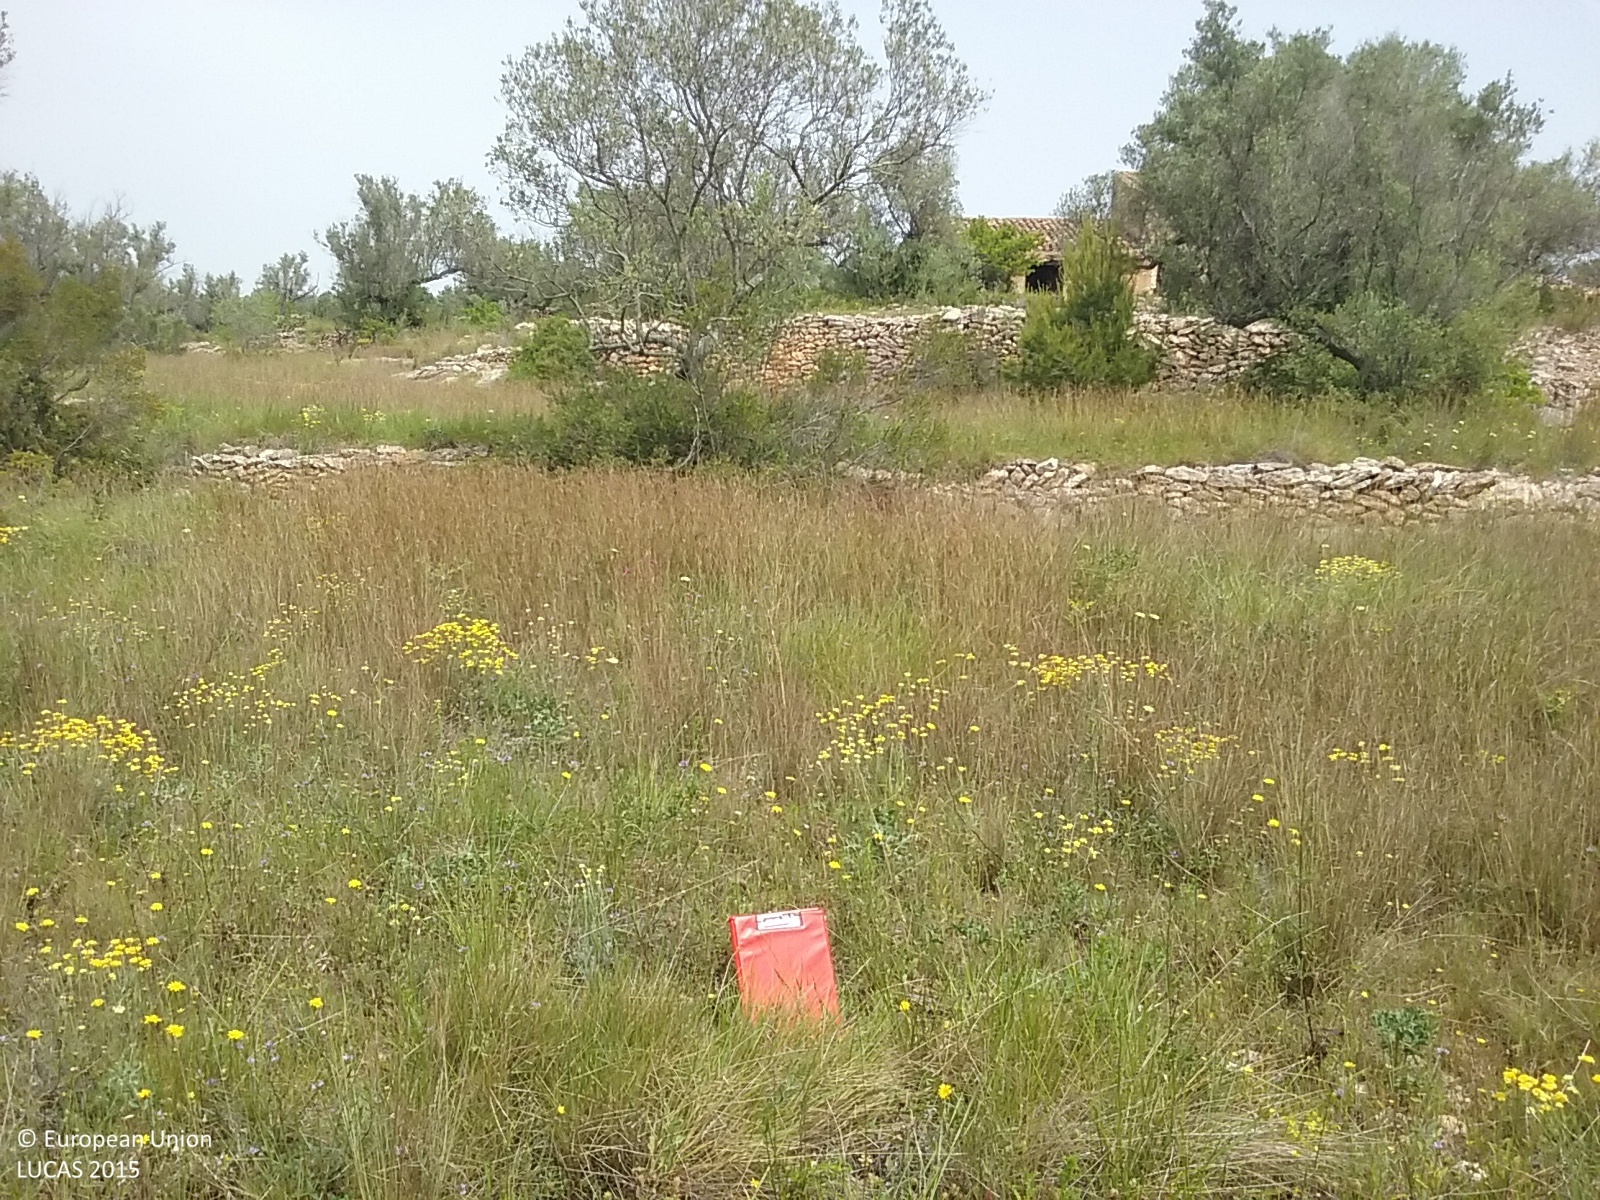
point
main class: Cropland
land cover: Olive groves
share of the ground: 25 - 50 %
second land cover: Grassland without tree/shrub cover
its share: > 75 %
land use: Abandoned areas
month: May
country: ES
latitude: 40.7974
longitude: 0.5954
